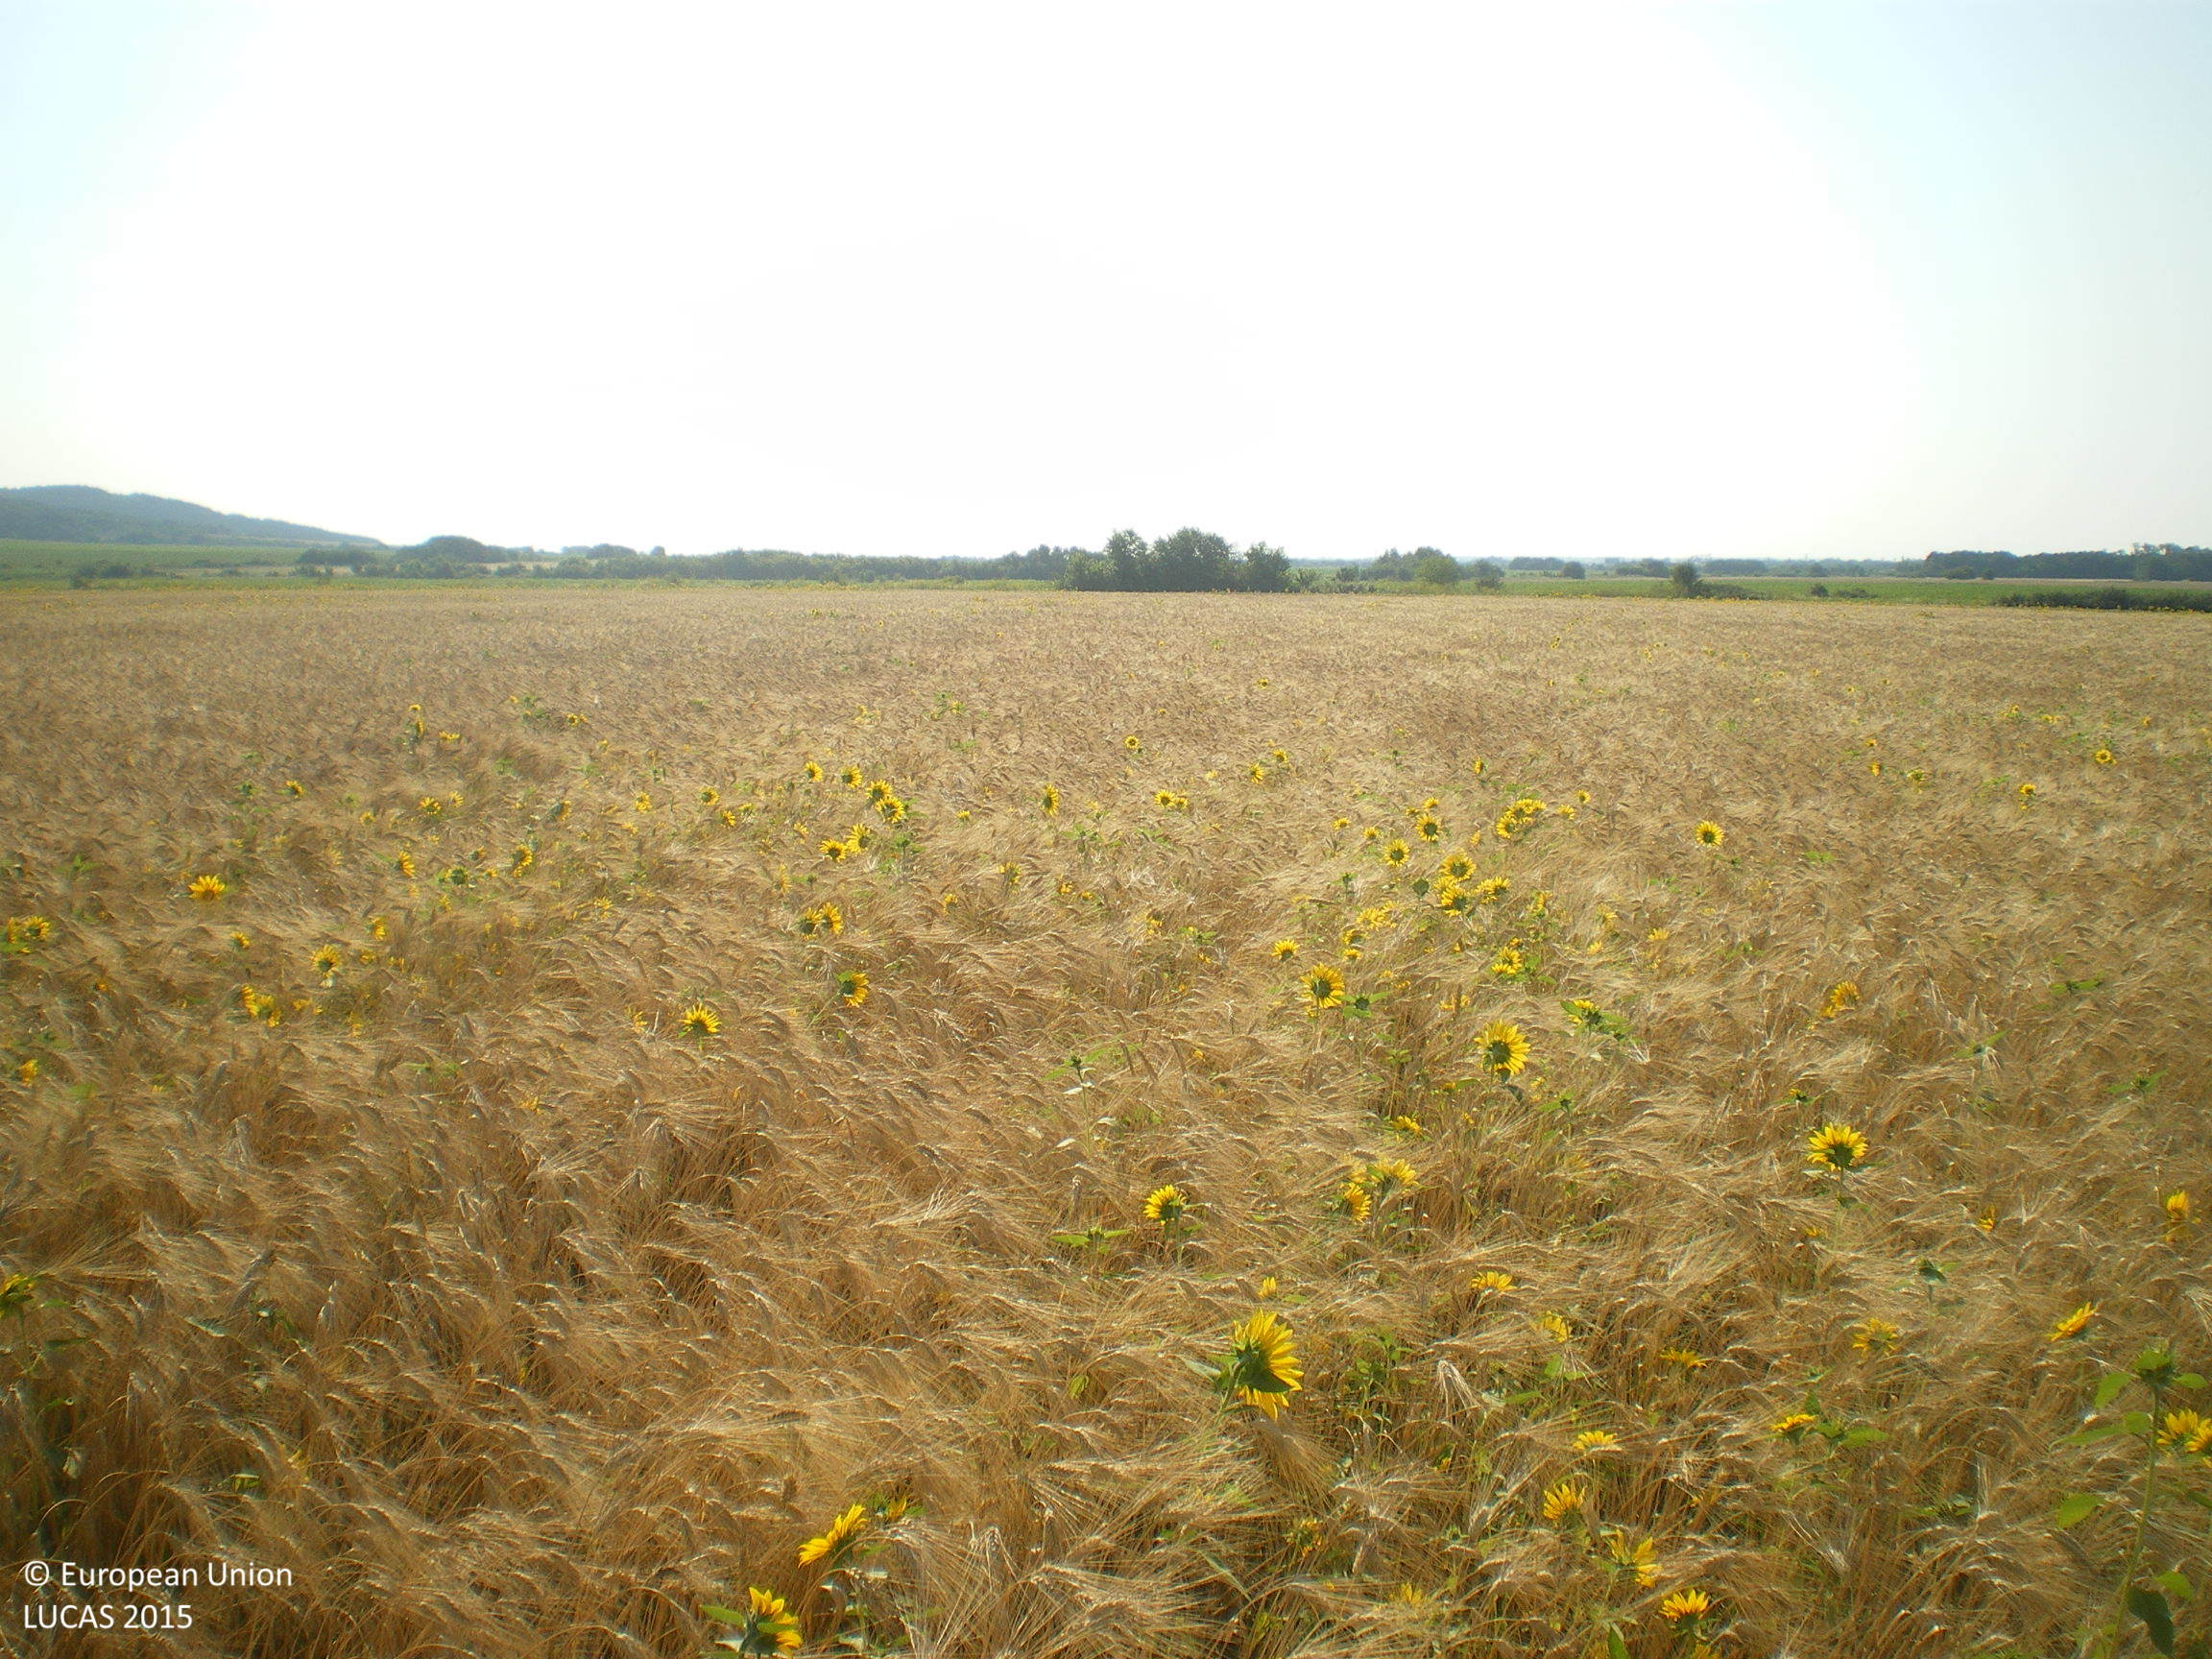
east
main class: Cropland
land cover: Barley
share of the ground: > 75 %
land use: Agriculture (excluding fallow land and kitchen gardens)
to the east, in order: Barley; Abandoned hedges
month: July
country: BG
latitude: 42.3270
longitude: 25.5412
